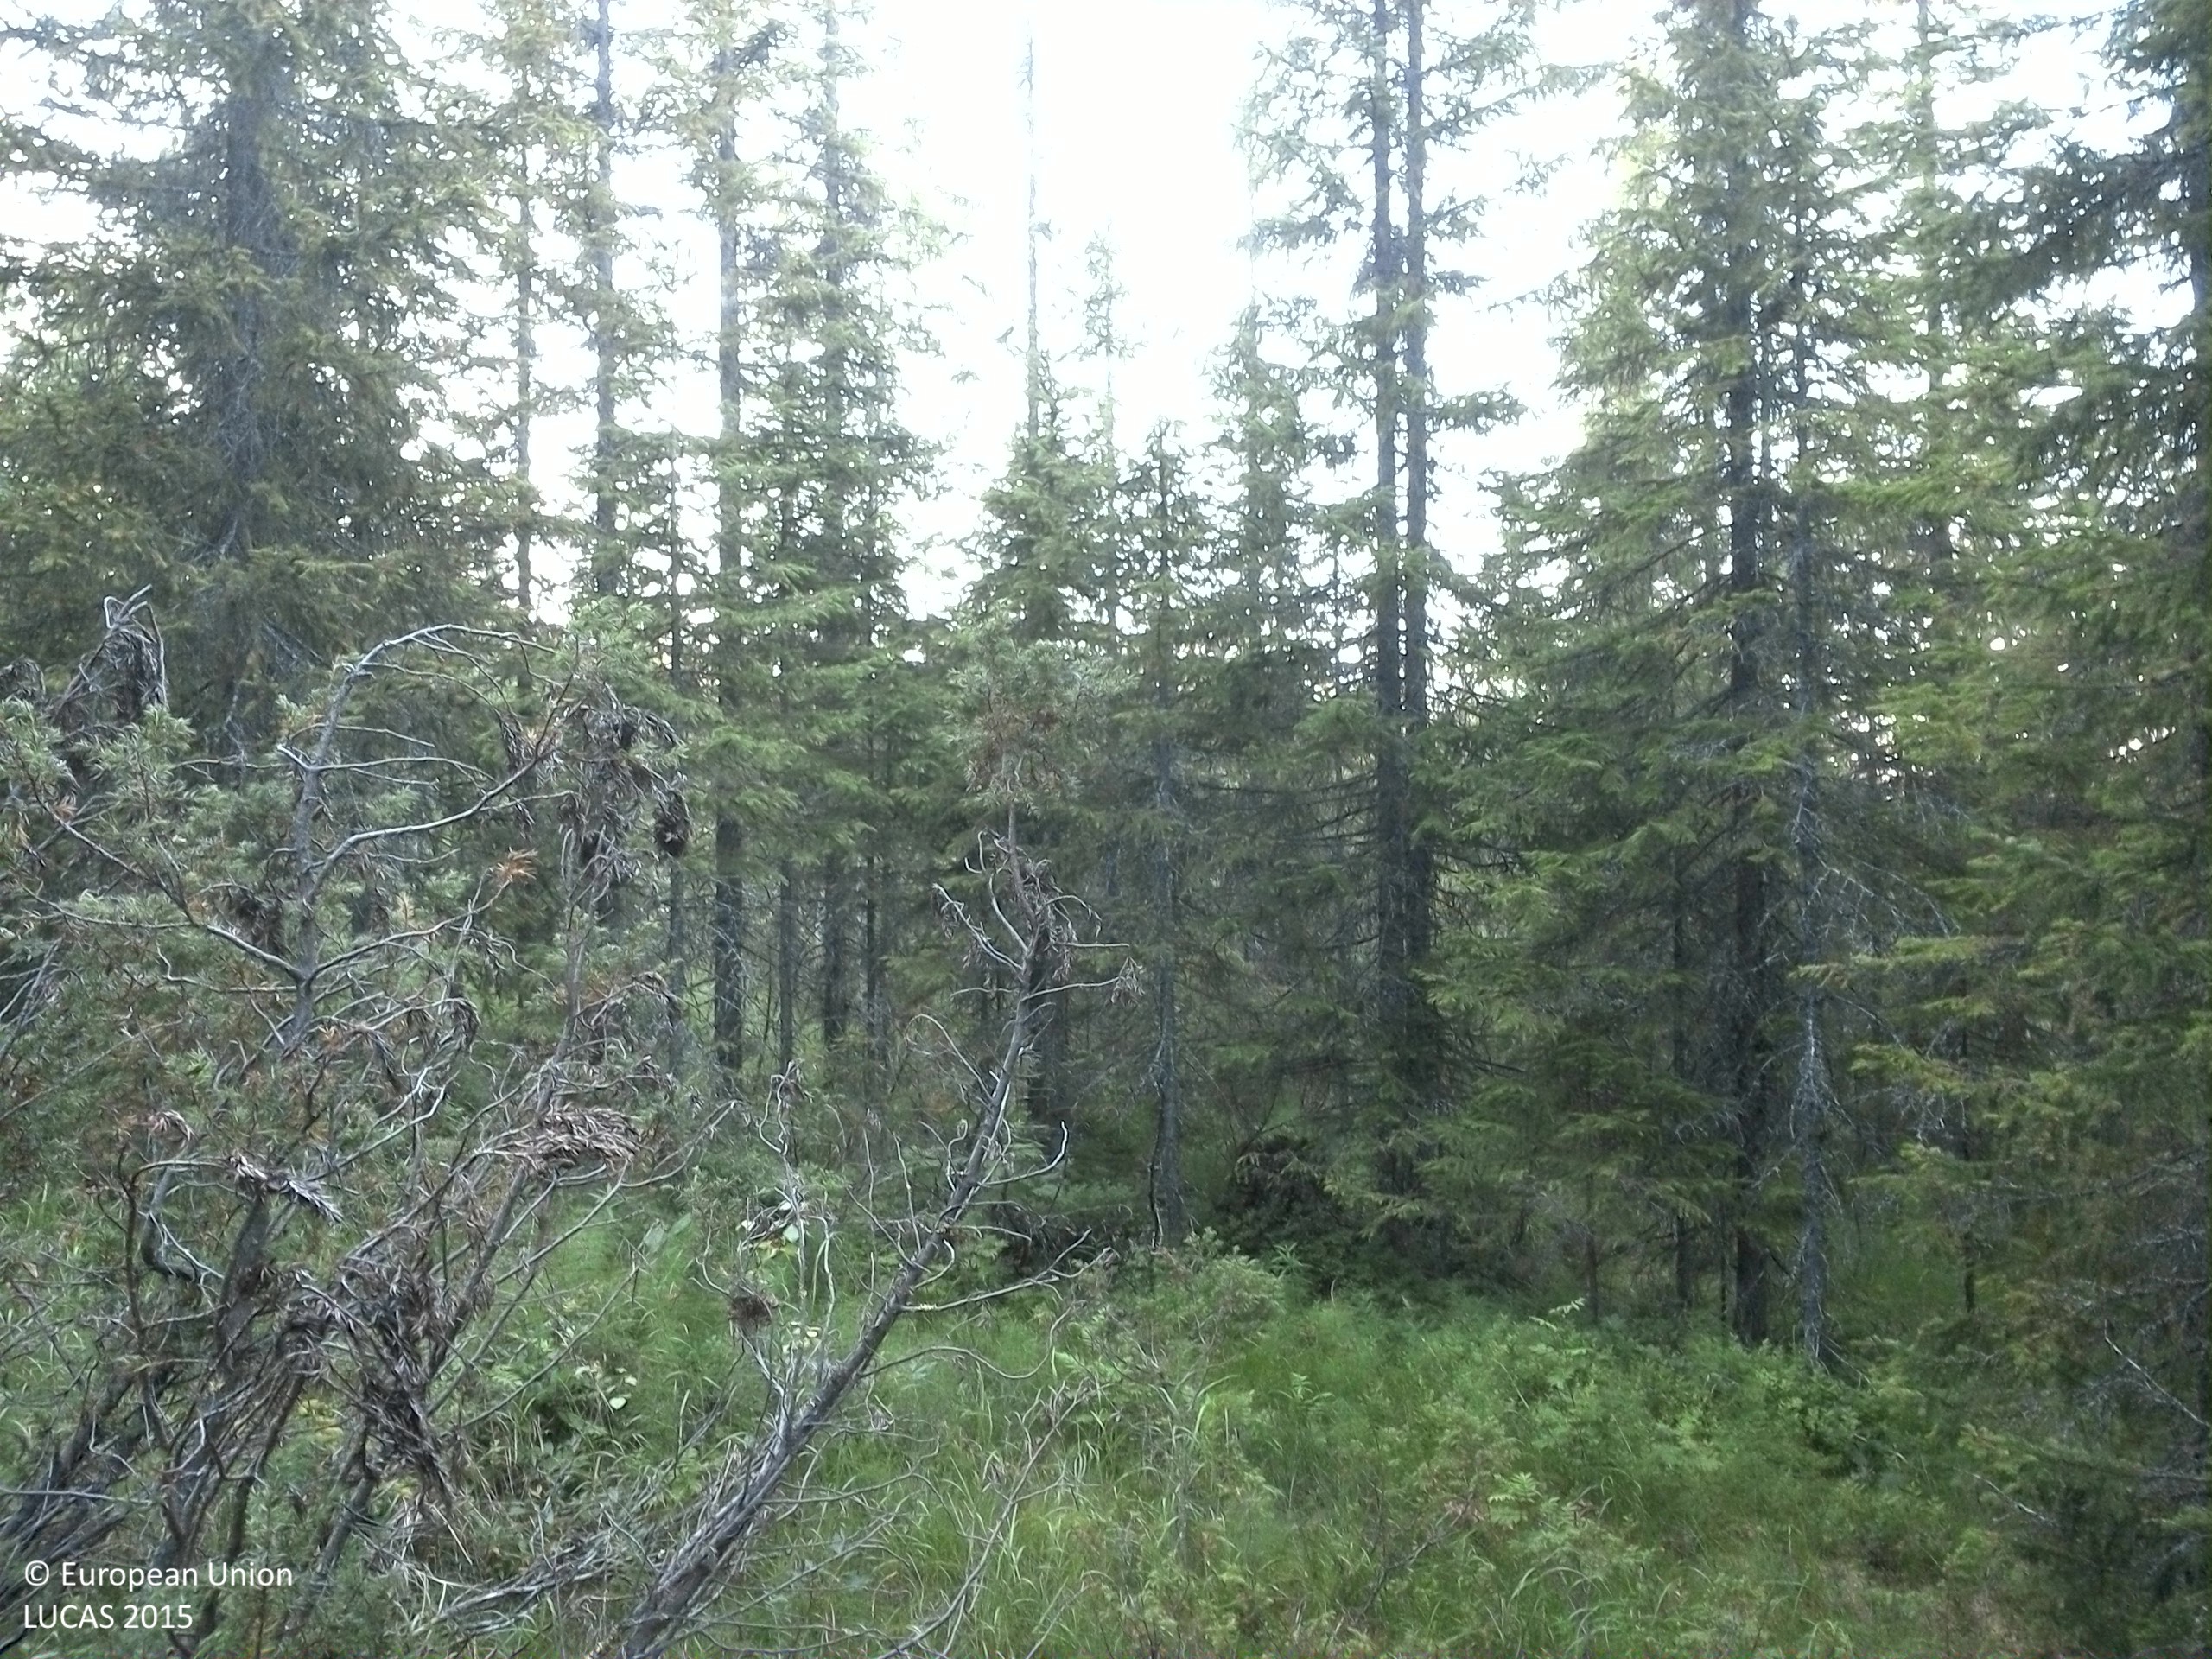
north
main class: Woodland
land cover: Spruce dominated mixed woodland
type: boreal forest
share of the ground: > 75 %
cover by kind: coniferous forest trees 45 %, shrubs 25 %, broadleaved forest trees 20 %, herbaceous plants 10 %
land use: Forestry
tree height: > 5 m
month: August
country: SE
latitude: 63.8212
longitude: 17.8753
